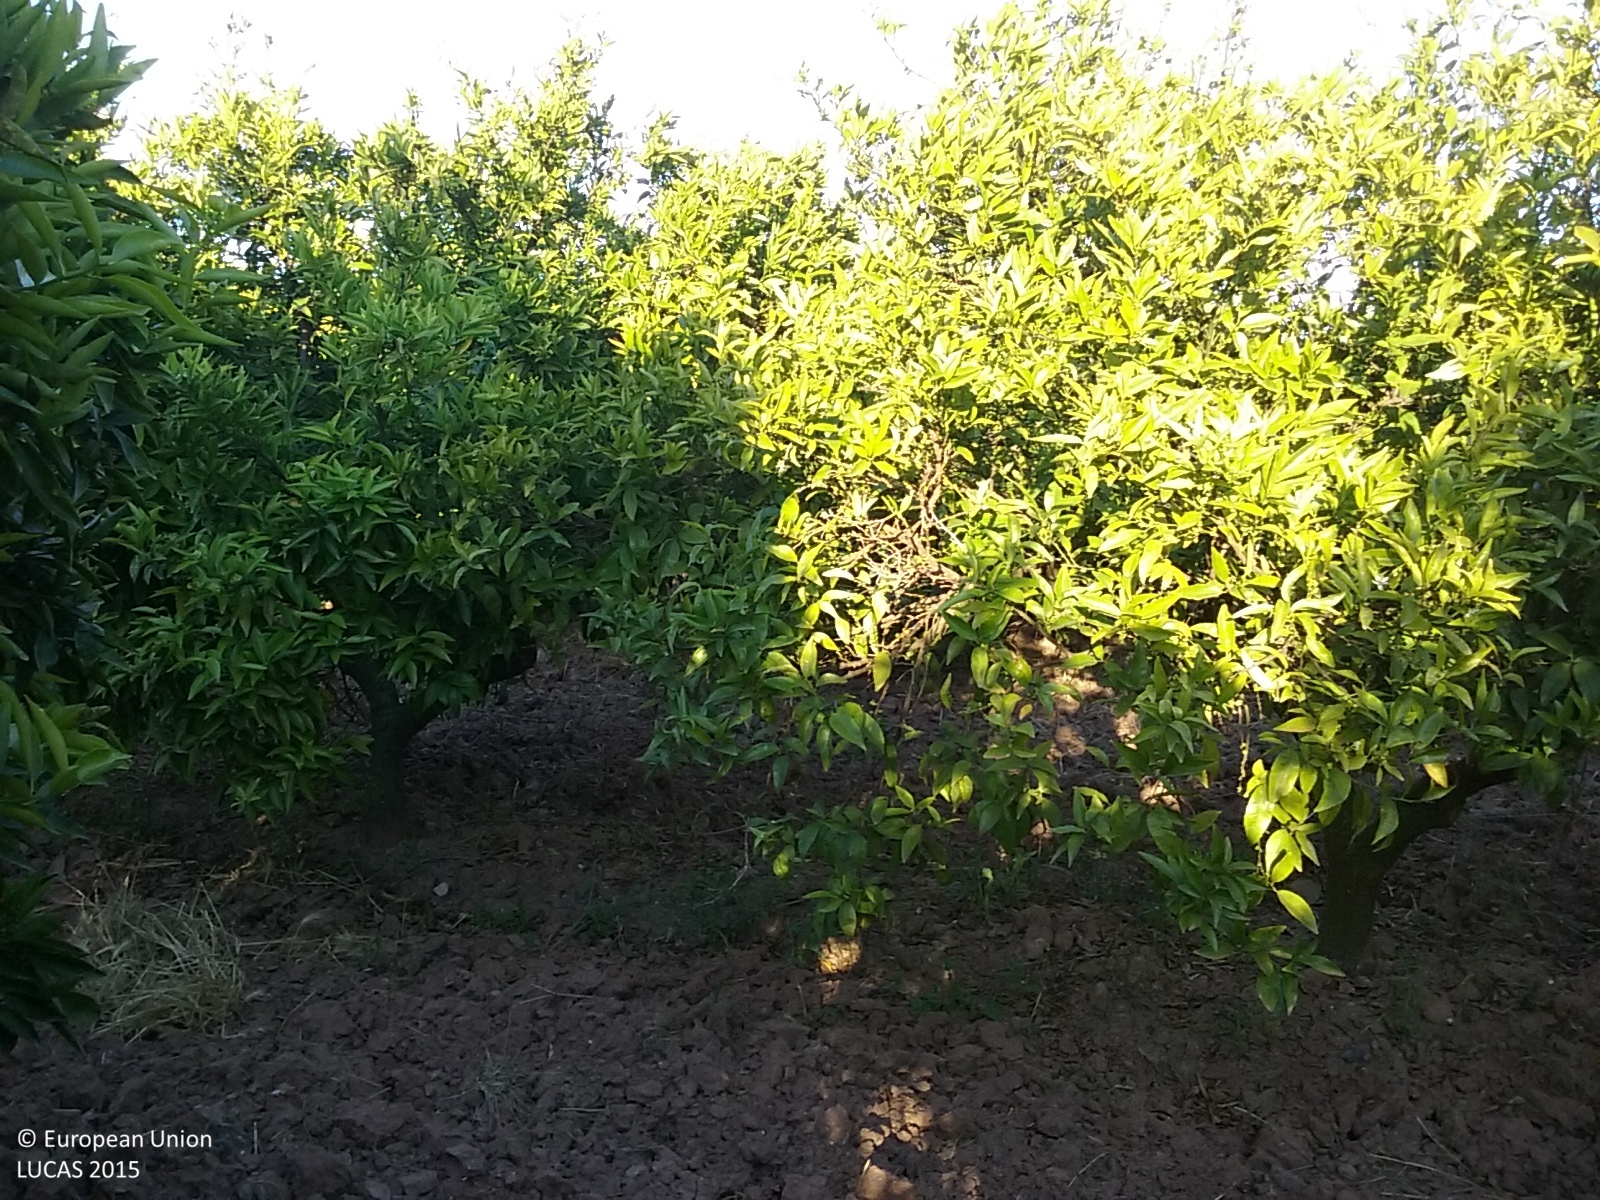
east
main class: Cropland
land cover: Other citrus fruit
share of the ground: 50 - 75 %
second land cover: Other bare soil
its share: > 75 %
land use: Agriculture (excluding fallow land and kitchen gardens)
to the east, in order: Other citrus fruit; Other bare soil; Artificial constructions in urban areas; Other citrus fruit; Artificial constructions; Paved roads, cycling and walking lanes; Ditches and canals; Other citrus fruit; Tracks; Ditches and canals; Other citrus fruit; Artificial constructions; Oranges; Artificial constructions in urban areas; Oranges; Artificial constructions; Oranges
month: May
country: ES
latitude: 39.9343
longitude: -0.0291
